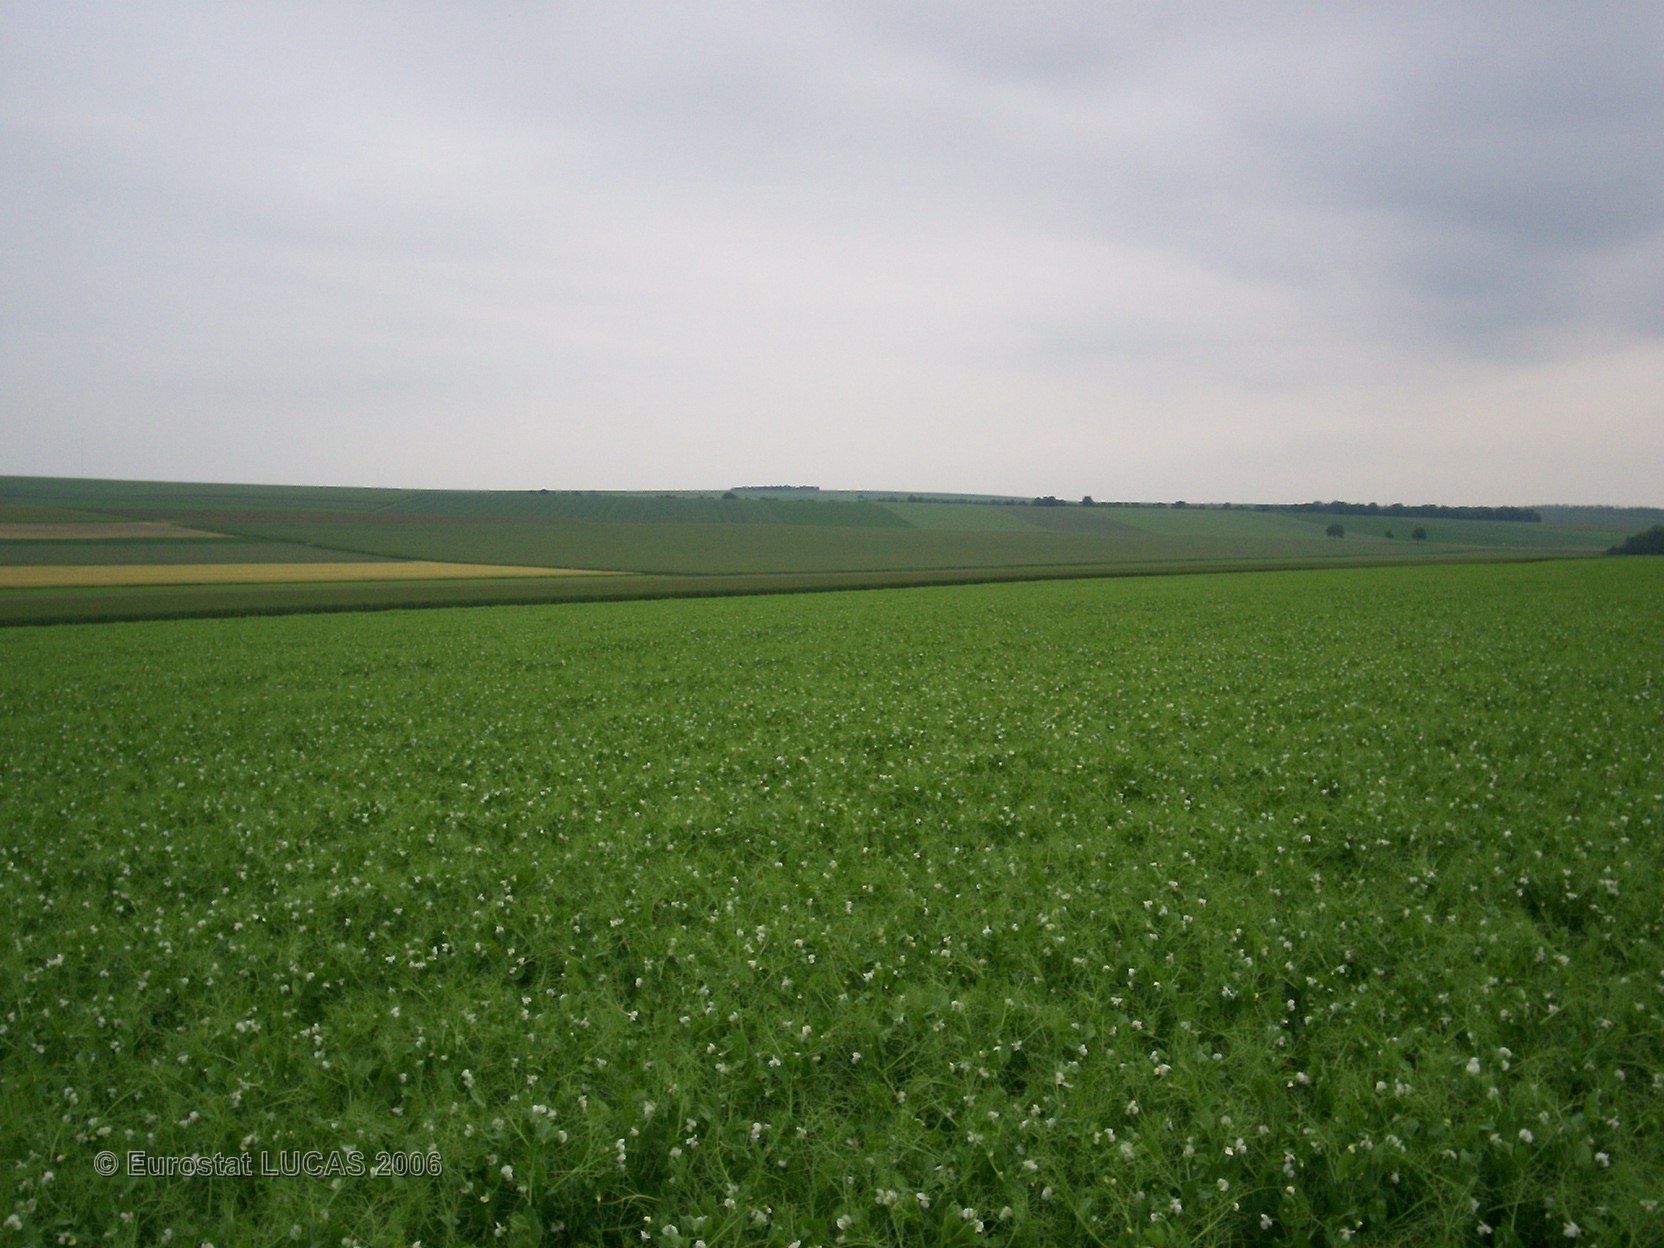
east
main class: Cropland
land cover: Dry pulses
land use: Agriculture (excluding fallow land and kitchen gardens)
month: June
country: FR
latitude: 48.7337
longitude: 4.4631
